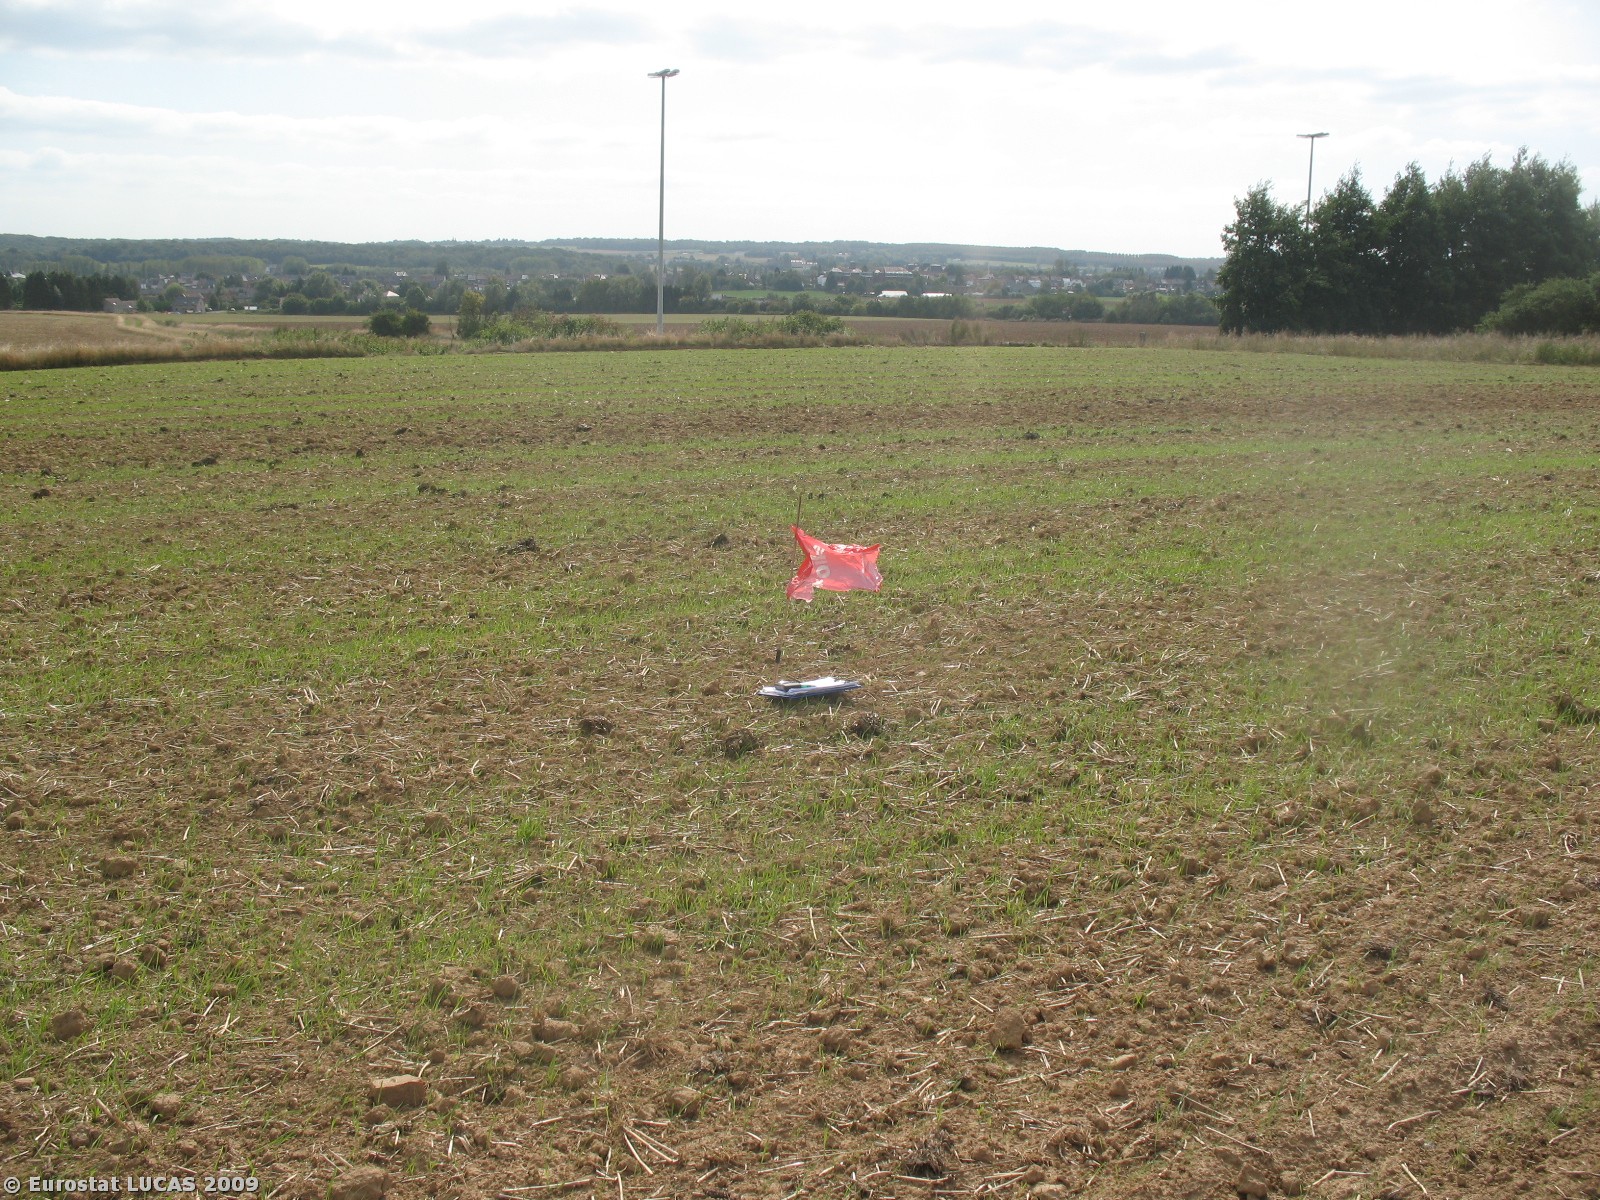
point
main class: Cropland
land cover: Temporary grasslands
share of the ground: < 10 %
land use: Agriculture (excluding fallow land and kitchen gardens)
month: September
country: BE
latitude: 50.3205
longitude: 4.1098
